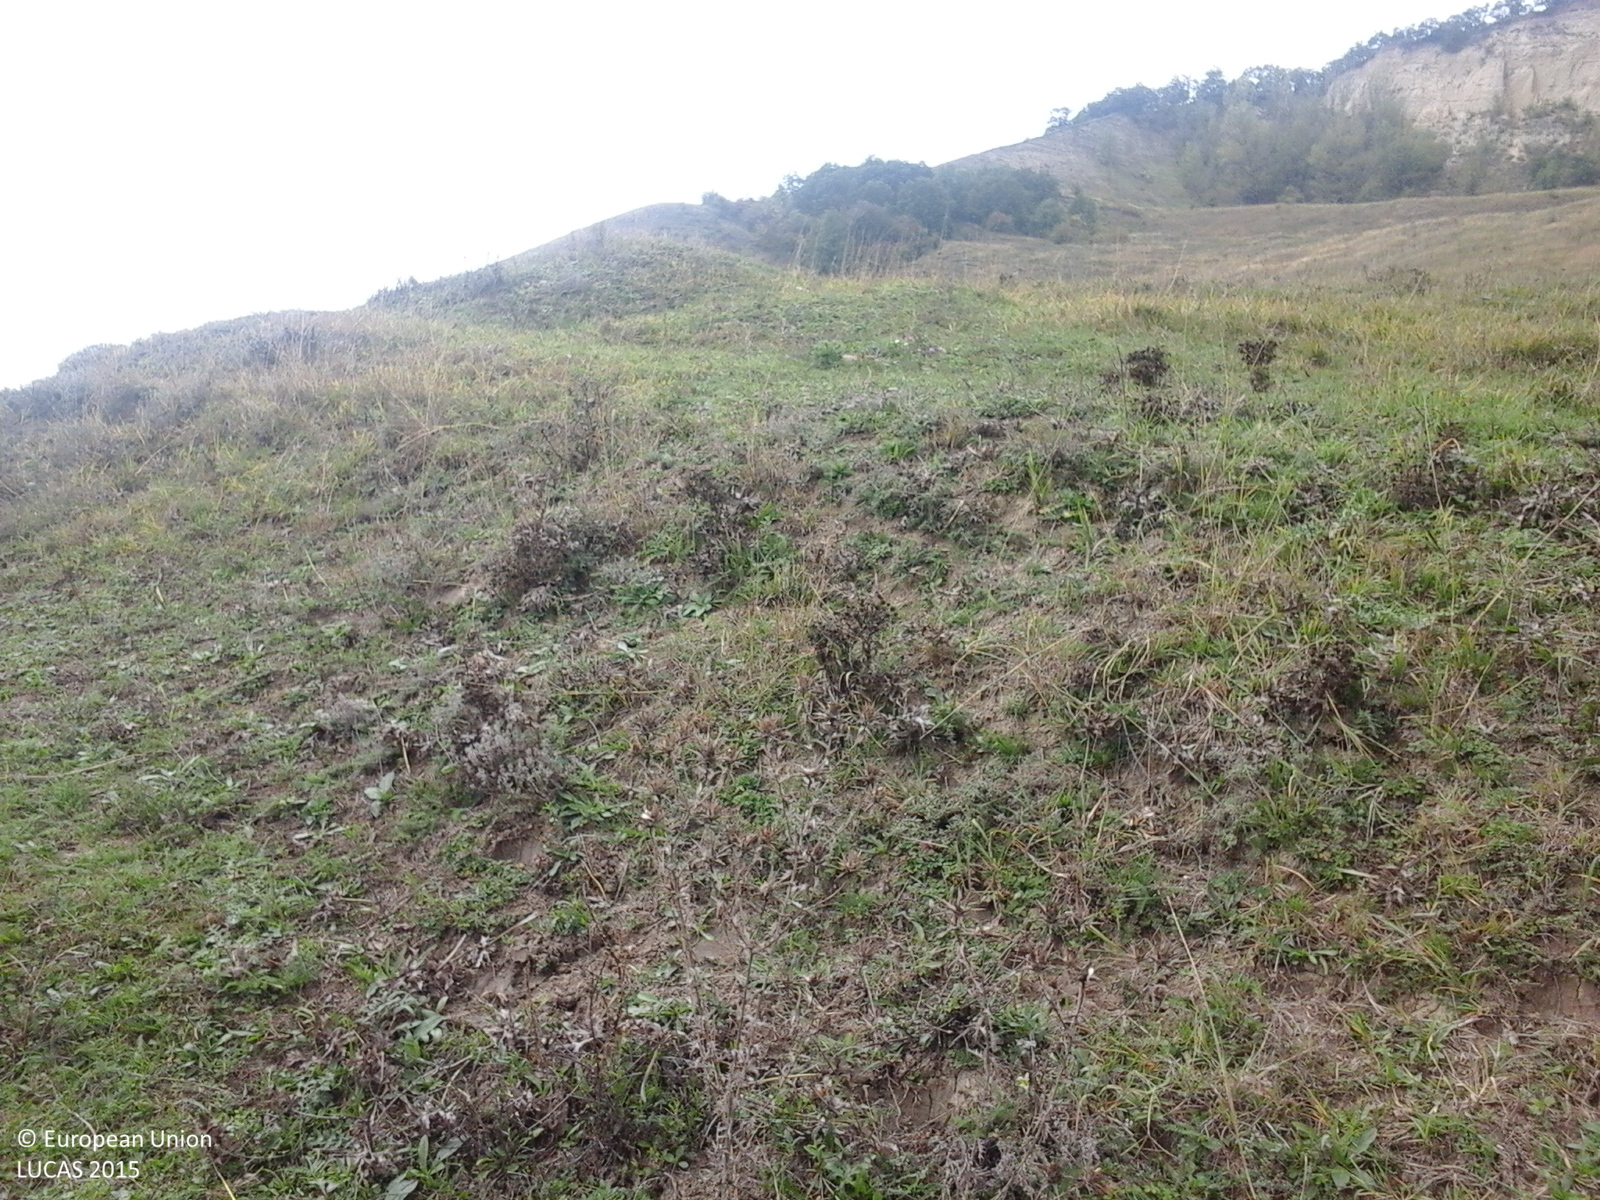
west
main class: Grassland
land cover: Grassland without tree/shrub cover
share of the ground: > 75 %
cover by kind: herbaceous plants 100 %
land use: Agriculture (excluding fallow land and kitchen gardens)
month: October
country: RO
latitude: 46.0899
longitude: 24.0825
